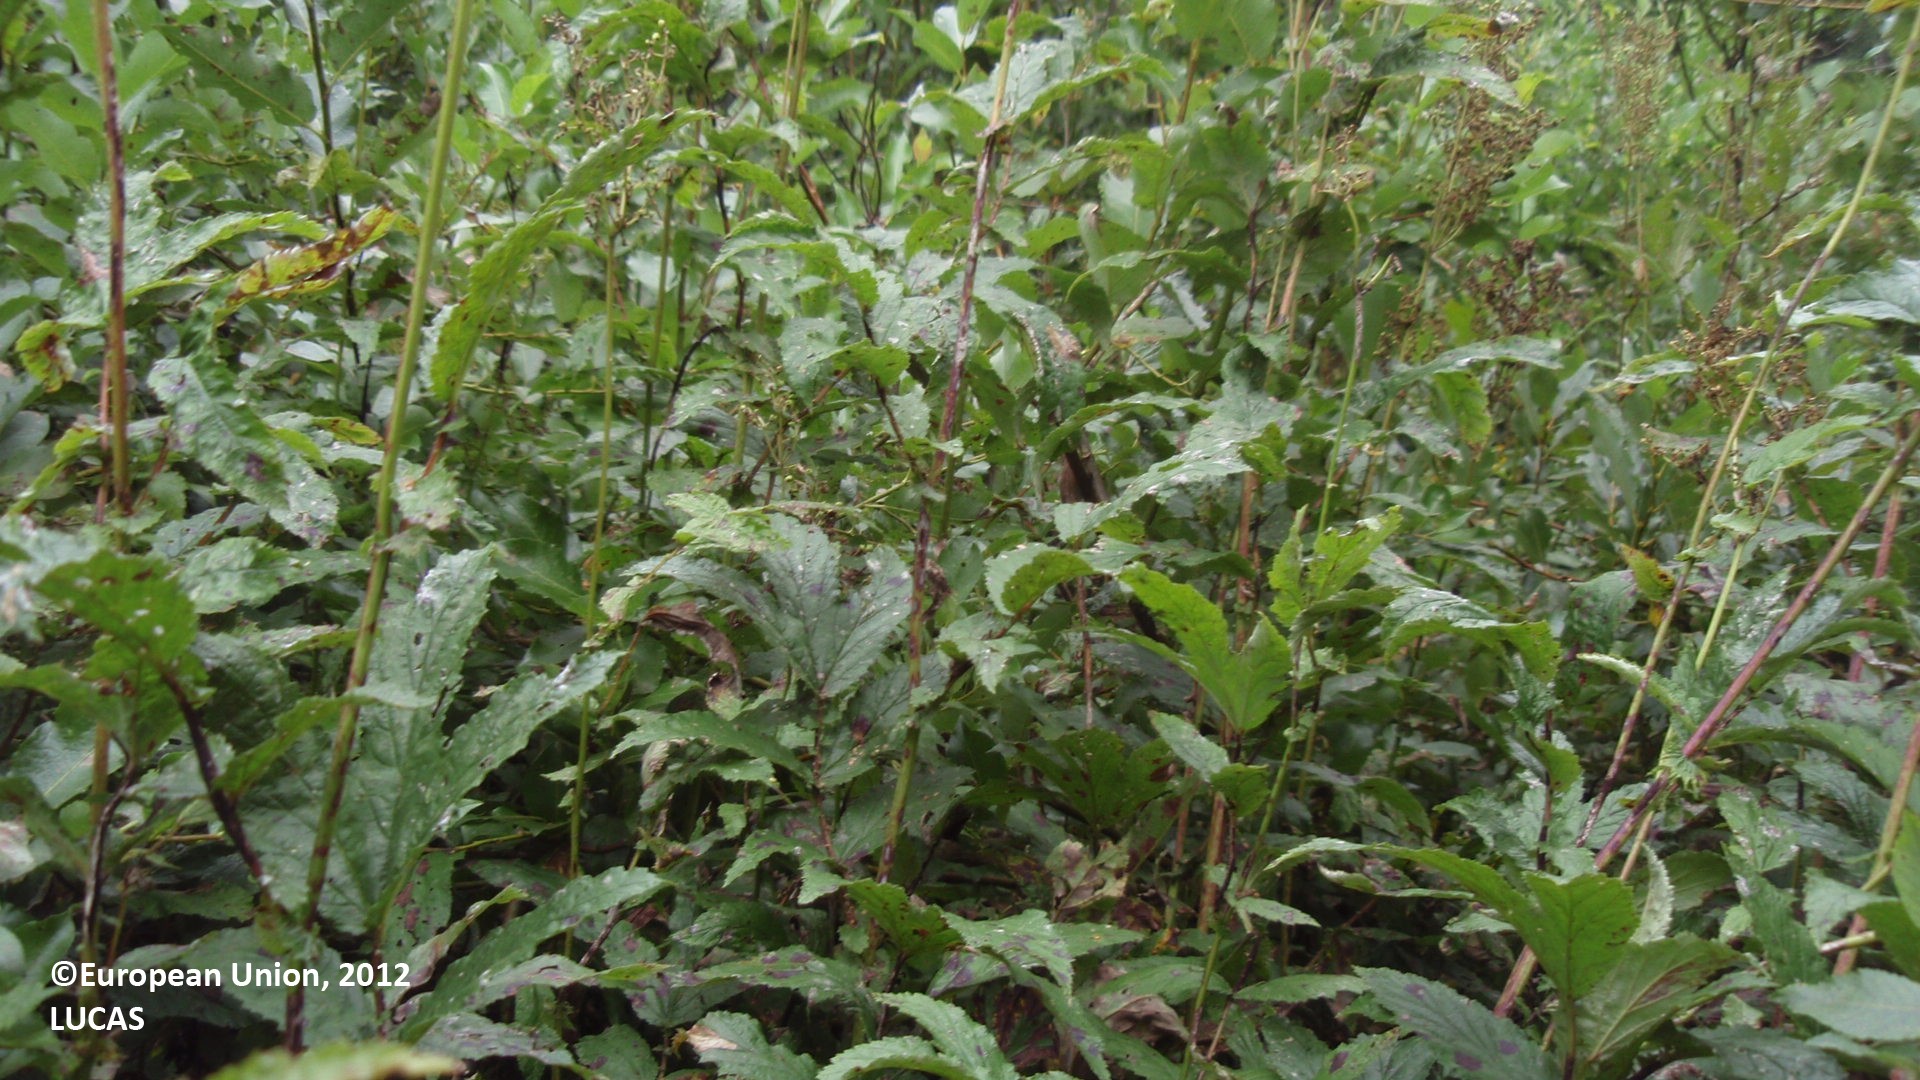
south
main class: Shrubland
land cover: Shrubland with sparse tree cover
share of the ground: > 75 %
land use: Abandoned areas
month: August
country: FI
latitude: 61.2540
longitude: 27.6889
